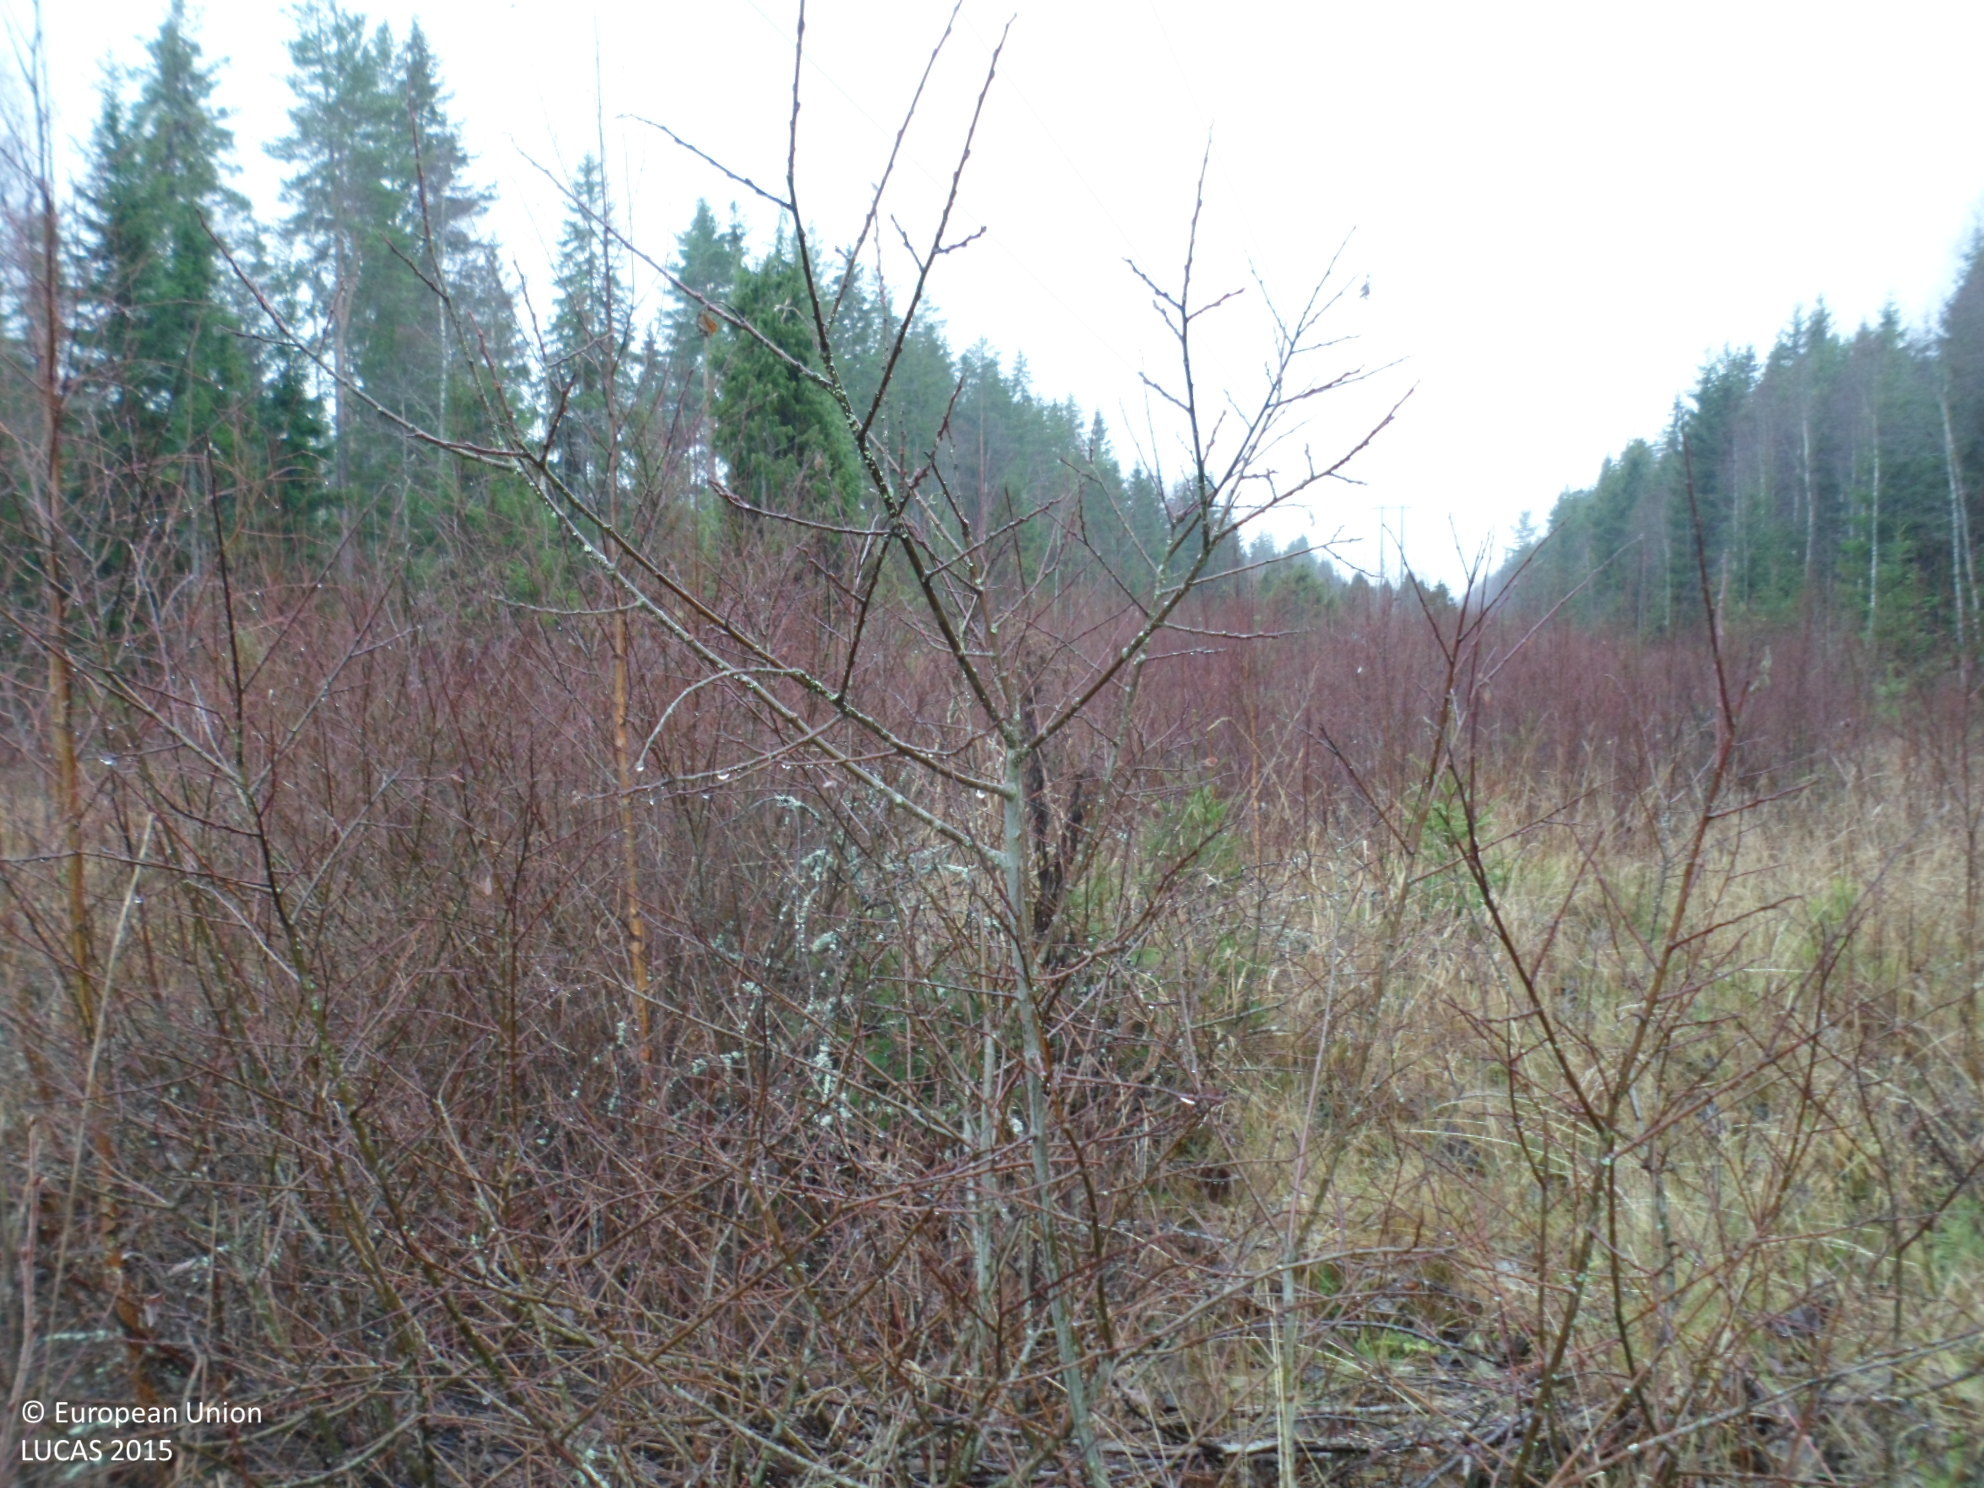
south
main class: Woodland
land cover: Broadleaved woodland
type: boreal forest
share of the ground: 50 - 75 %
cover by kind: broadleaved forest trees 55 %, herbaceous plants 30 %, shrubs 15 %
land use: Electricity, gas and thermal power distribution
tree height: < 5 m
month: November
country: SE
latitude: 57.7560
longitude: 14.7848
